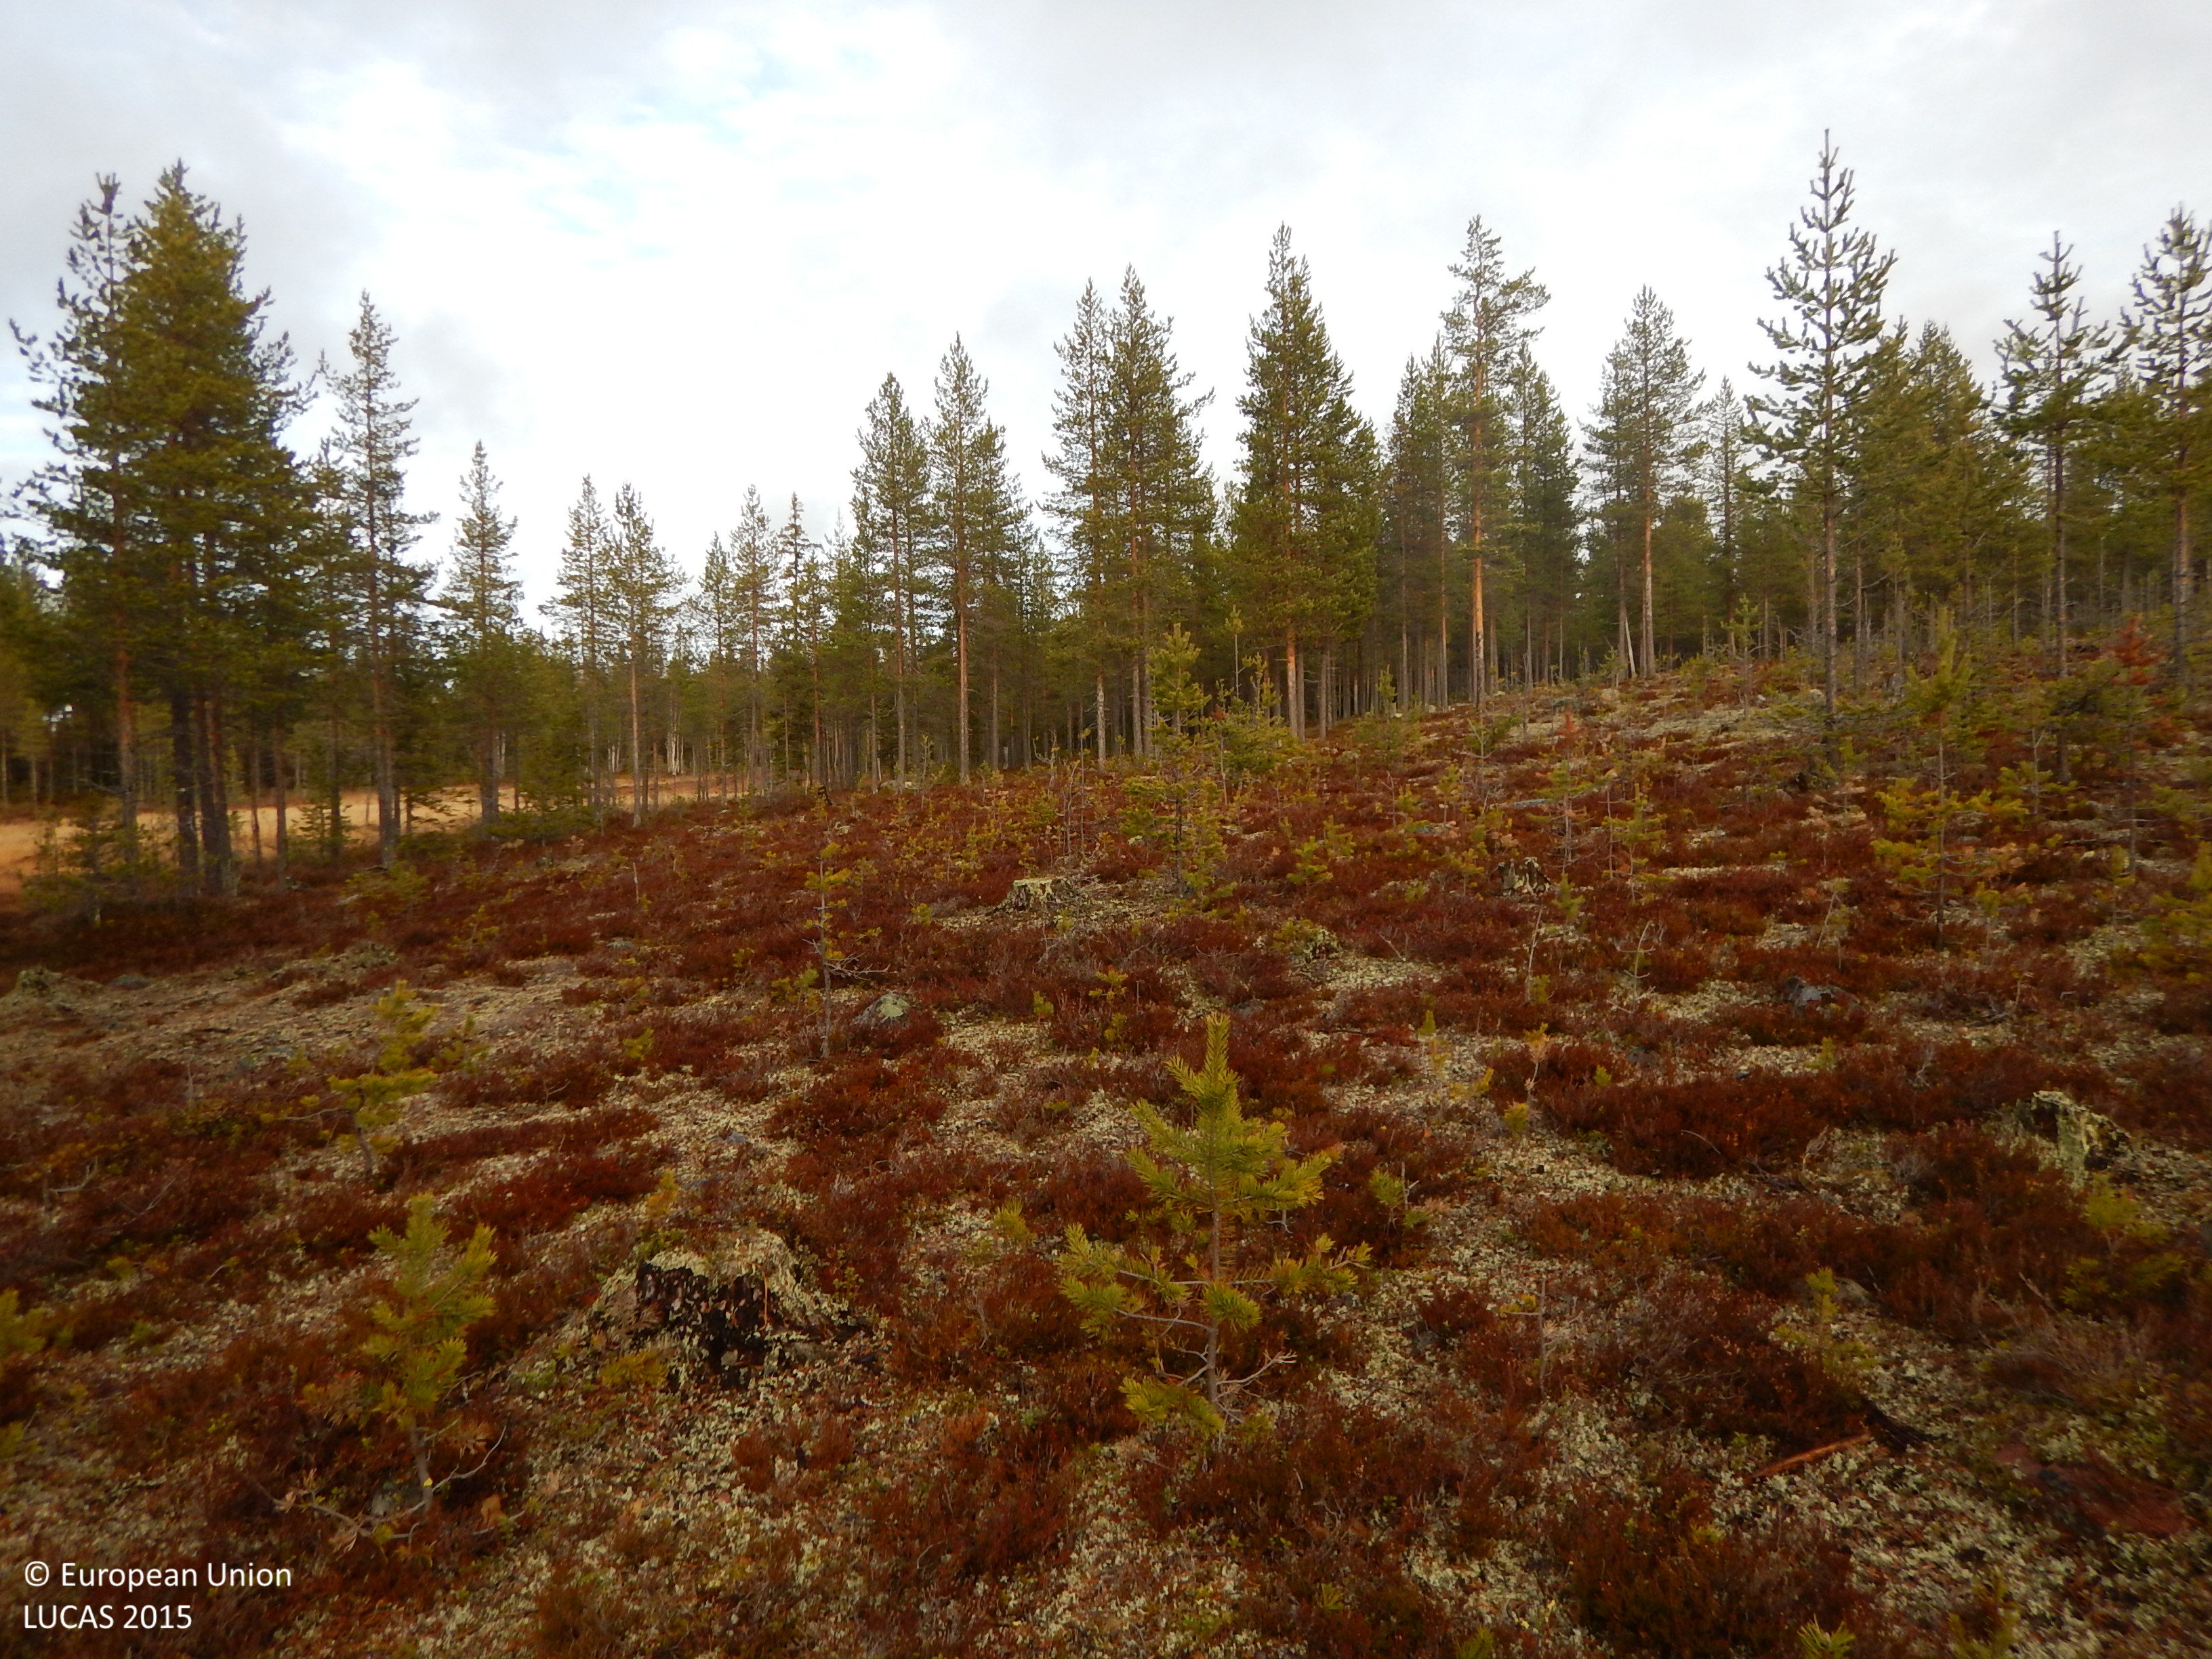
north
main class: Woodland
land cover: Pine dominated coniferous woodland
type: boreal forest
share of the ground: 10 - 25 %
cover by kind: shrubs 50 %, coniferous forest trees 25 %, lichens and mosses 20 %, herbaceous plants 5 %
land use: Forestry
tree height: < 5 m
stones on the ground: < 10 %
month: October
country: SE
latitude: 65.2818
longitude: 20.0617
